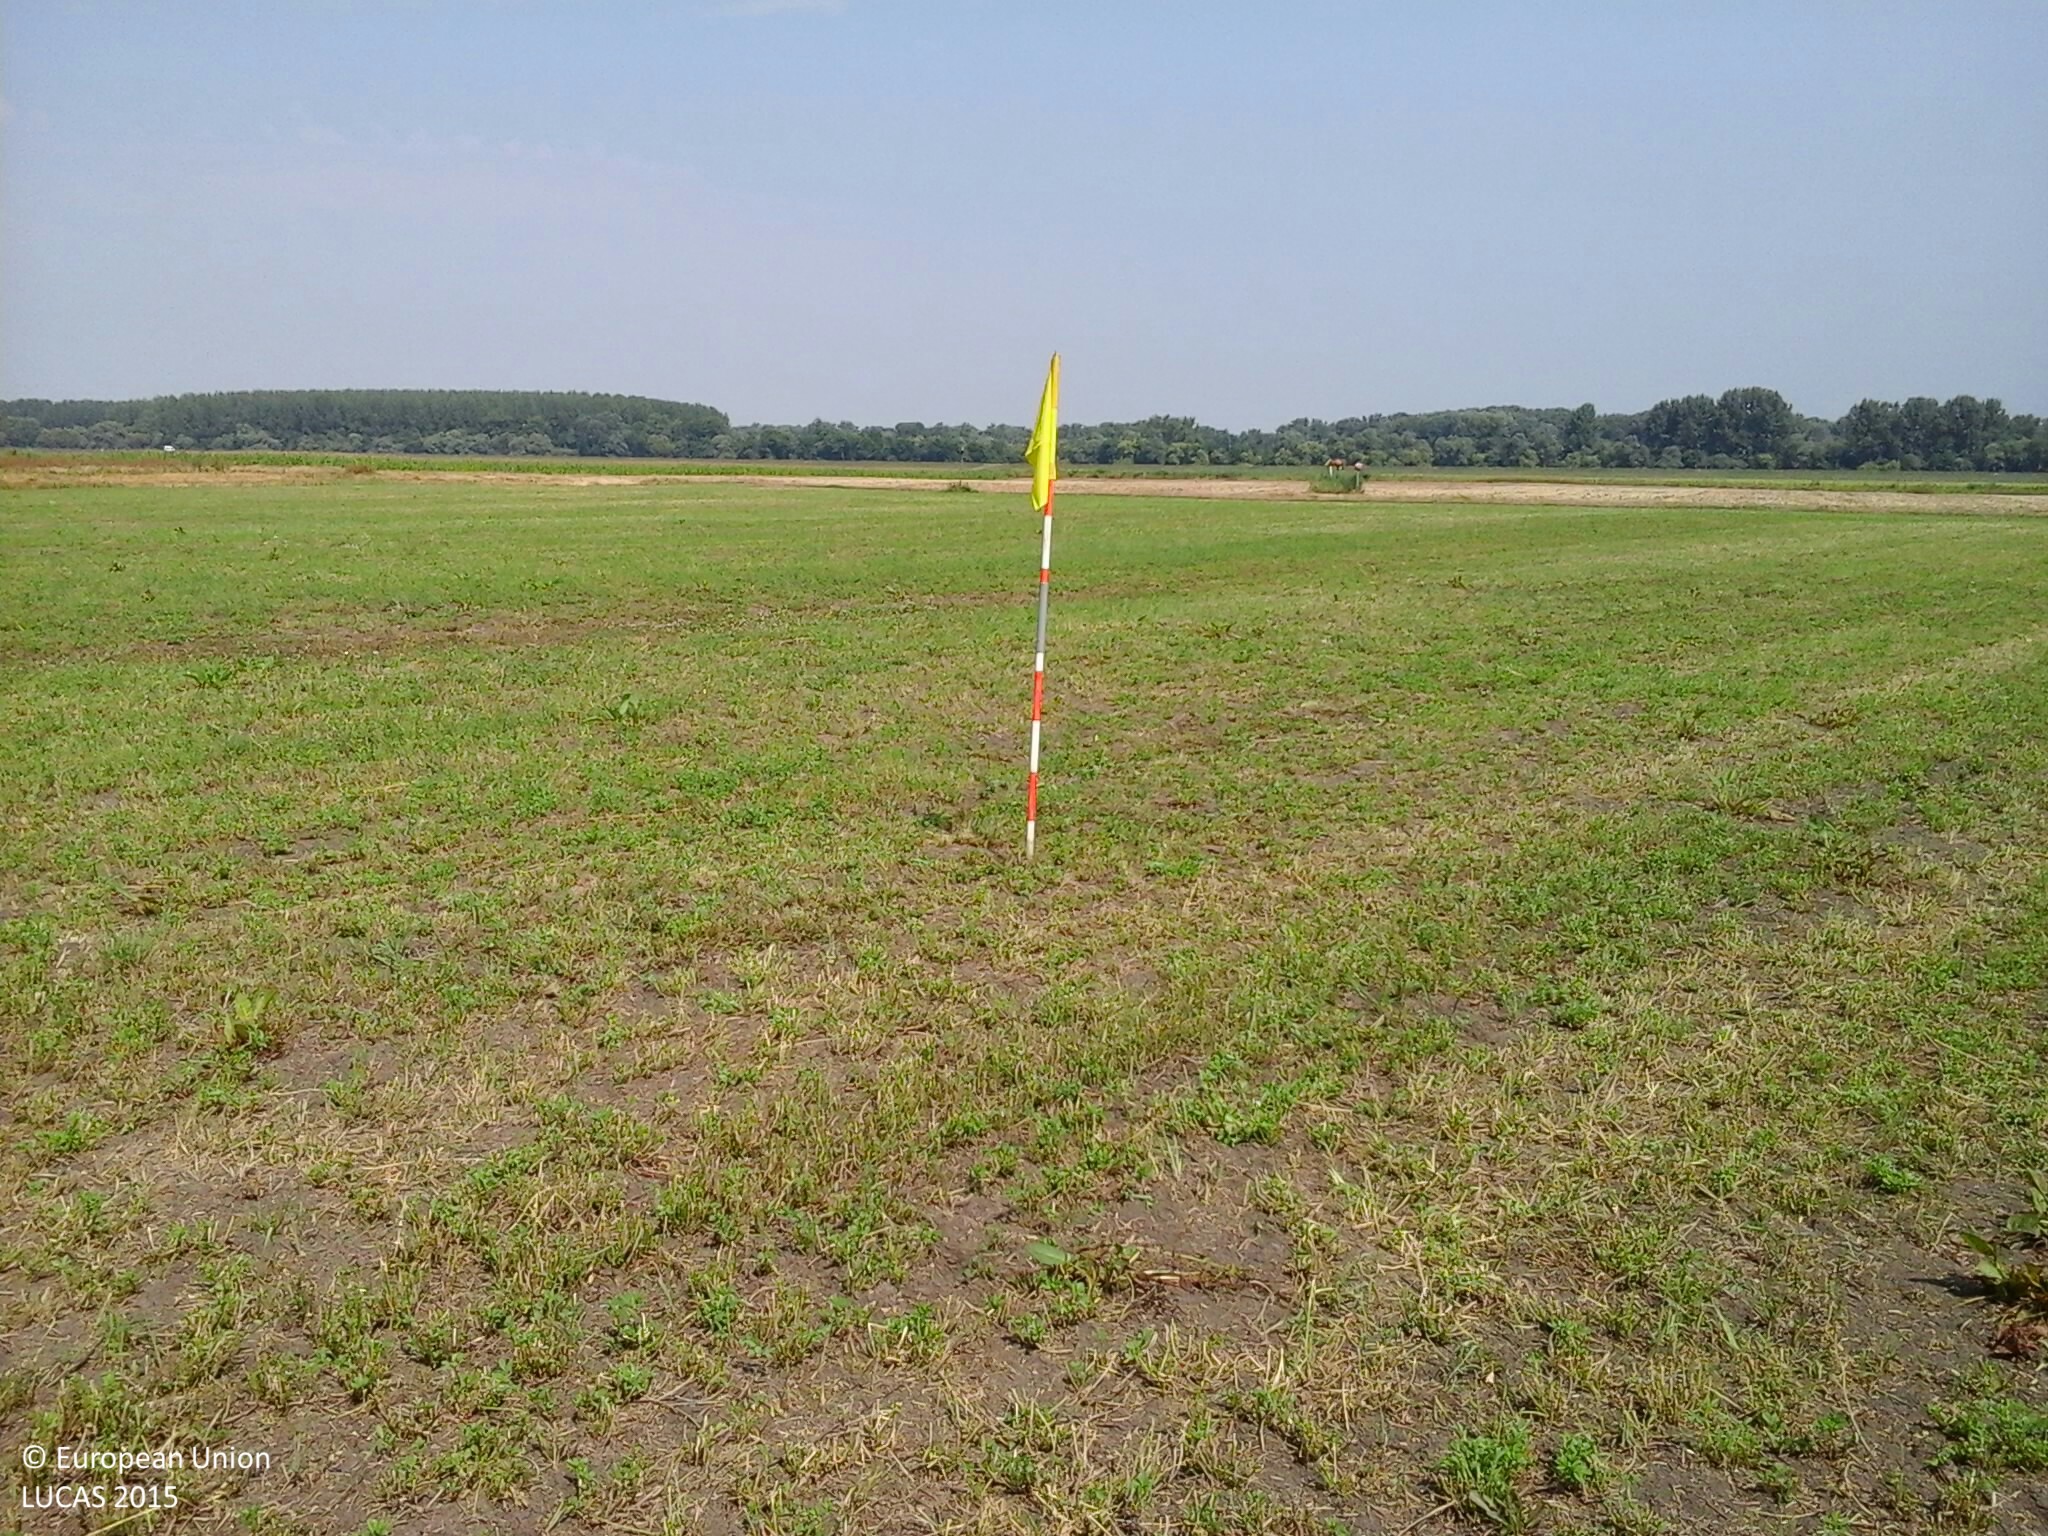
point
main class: Cropland
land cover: Lucerne
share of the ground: 50 - 75 %
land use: Agriculture (excluding fallow land and kitchen gardens)
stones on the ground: < 10 %
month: August
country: HU
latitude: 47.7096
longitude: 20.9798
